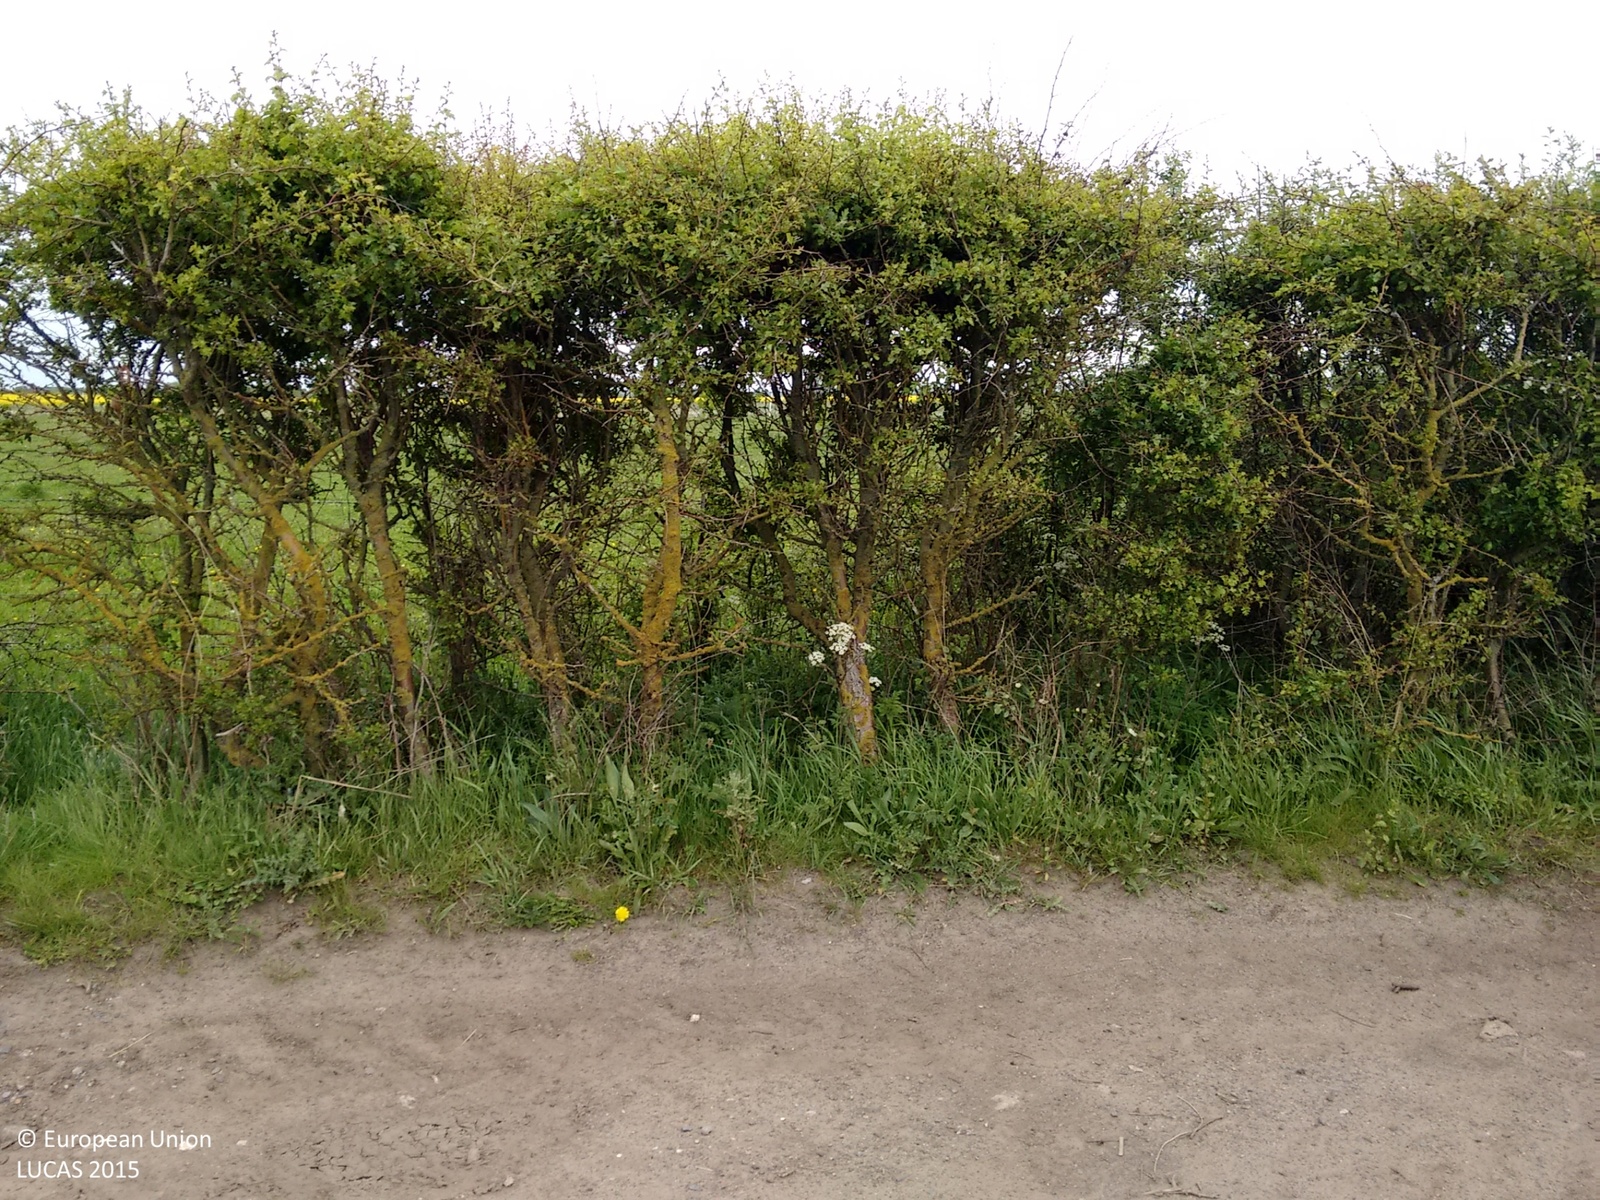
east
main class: Cropland
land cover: Potatoes
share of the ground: 10 - 25 %
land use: Agriculture (excluding fallow land and kitchen gardens)
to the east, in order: Potatoes; Grass margins; Tracks; Grass margins; Managed hedges; Grassland without tree/shrub cover
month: May
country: GB
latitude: 53.5736
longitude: -2.9857
